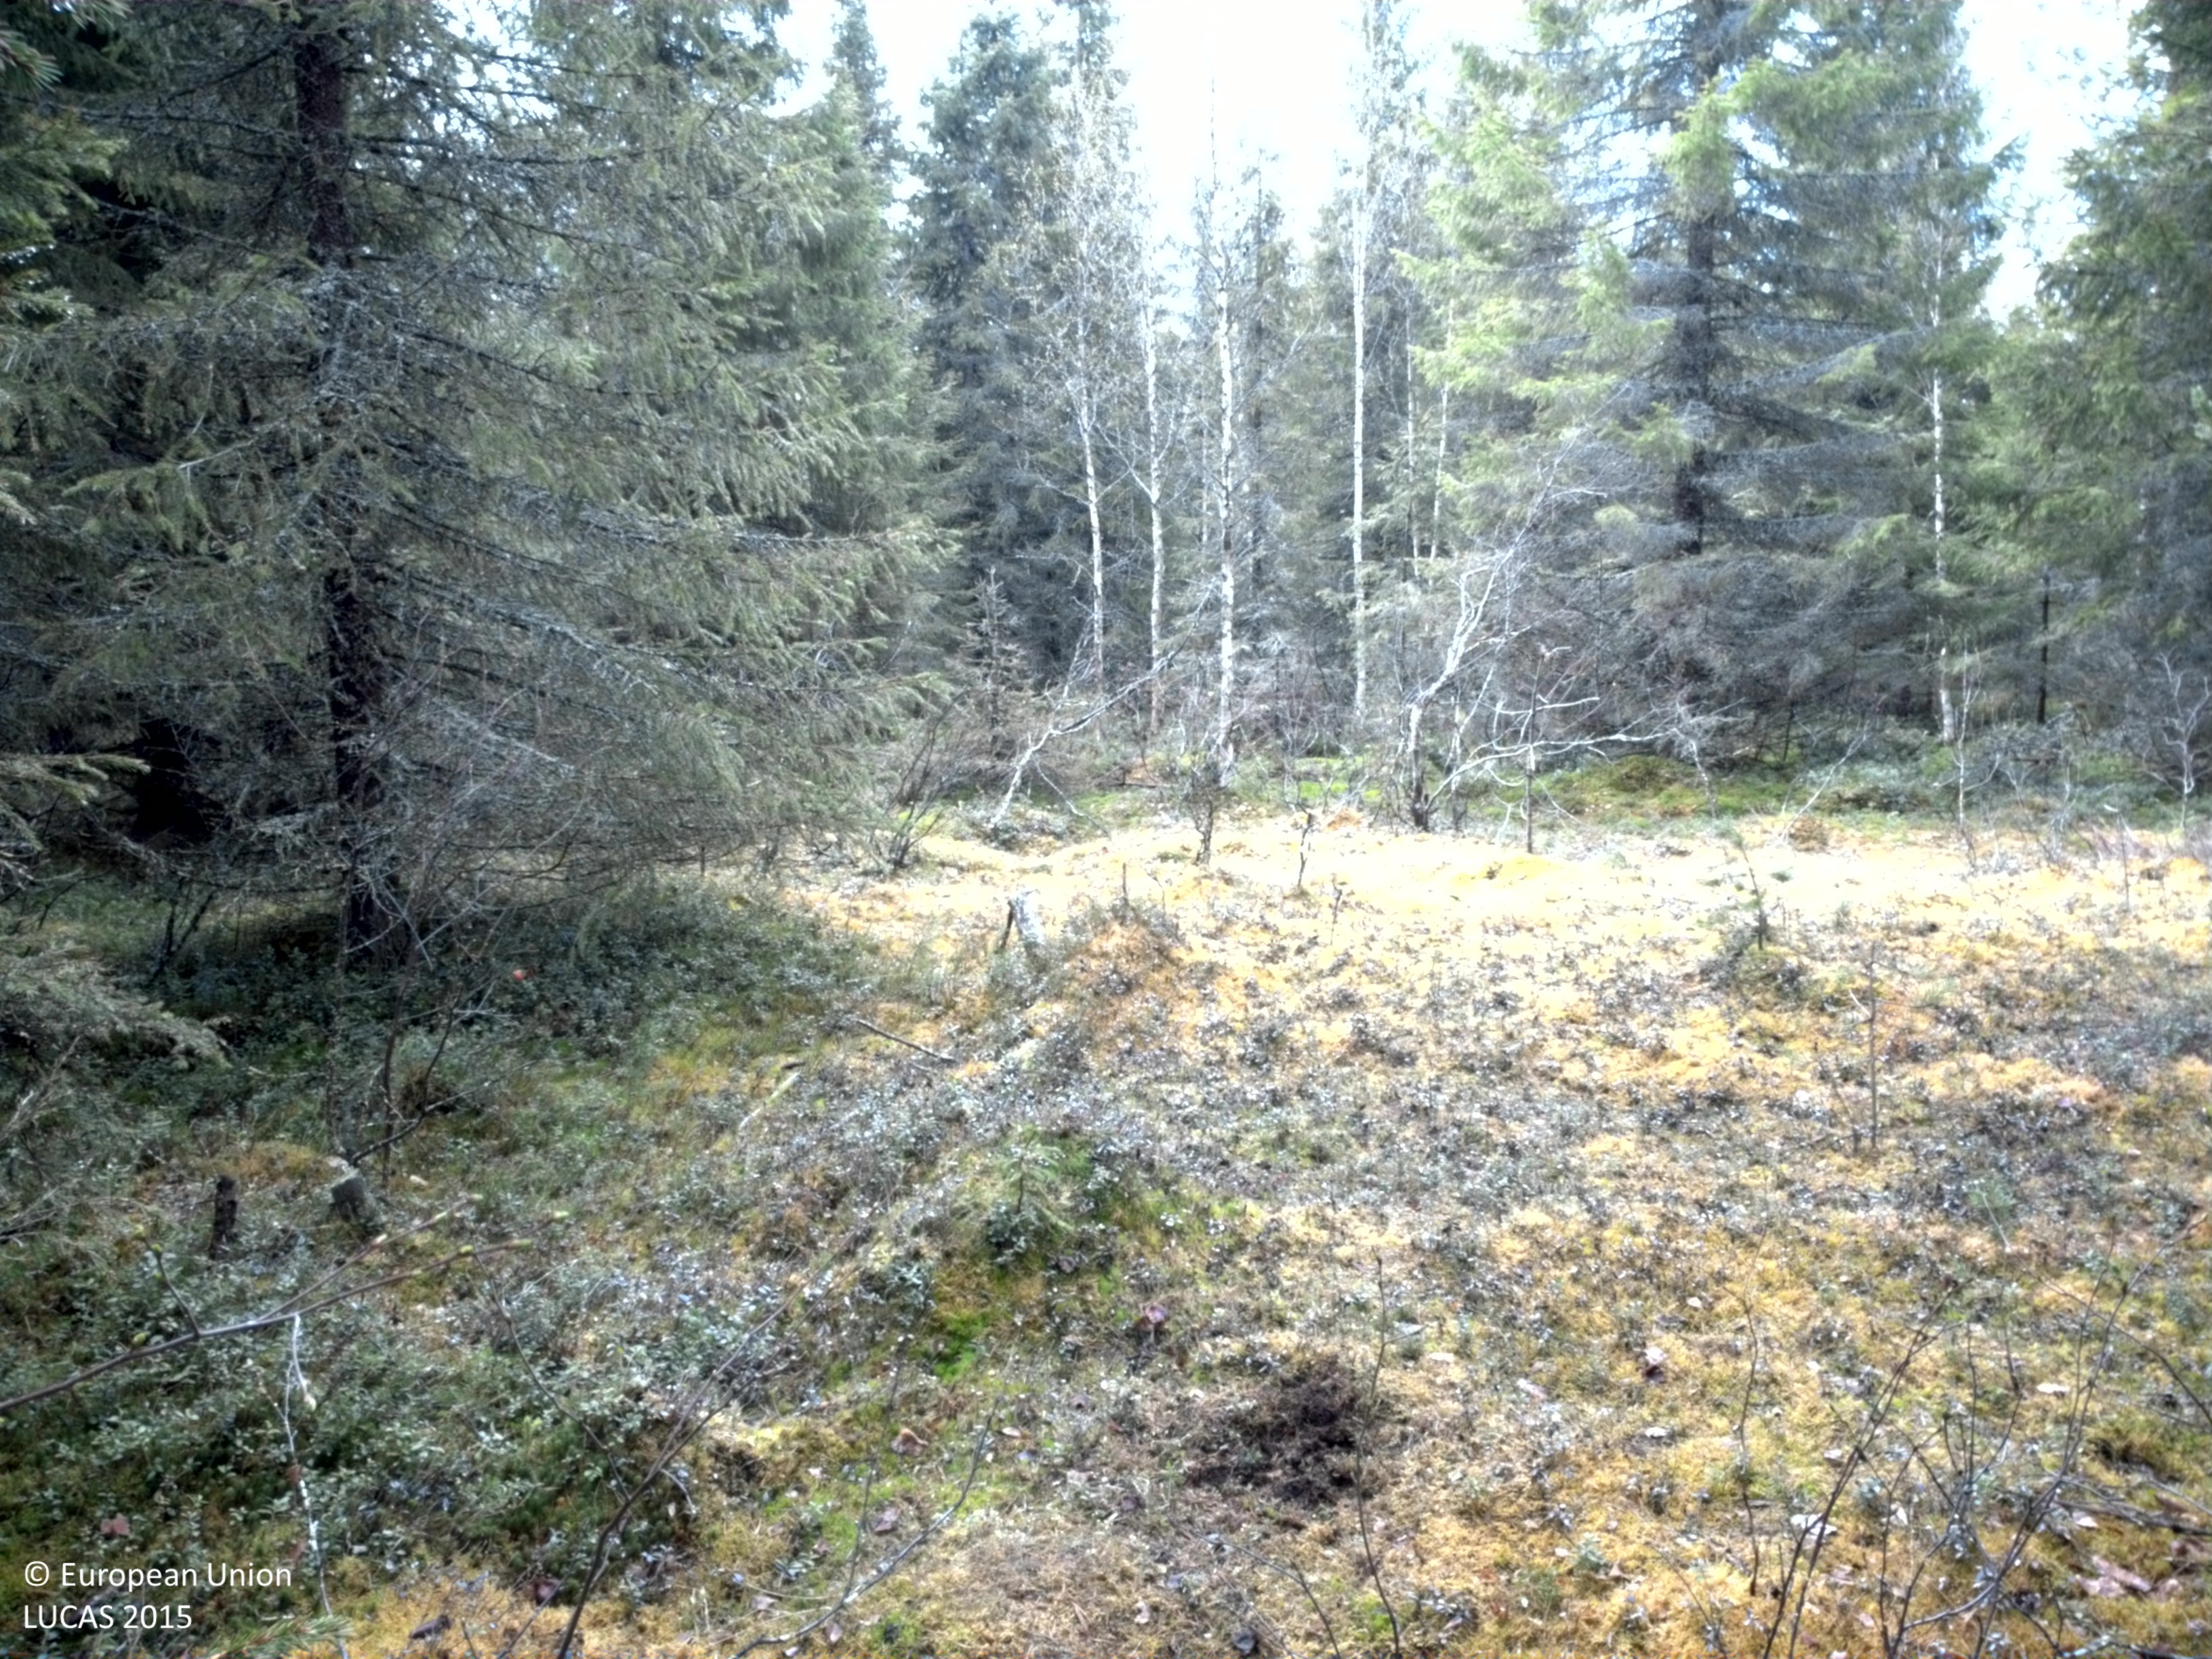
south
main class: Woodland
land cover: Spruce dominated coniferous woodland
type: boreal forest
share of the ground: > 75 %
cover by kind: coniferous forest trees 75 %, shrubs 10 %, lichens and mosses 10 %, broadleaved forest trees 5 %
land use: Forestry
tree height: > 5 m
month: May
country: SE
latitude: 66.0674
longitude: 23.6672
